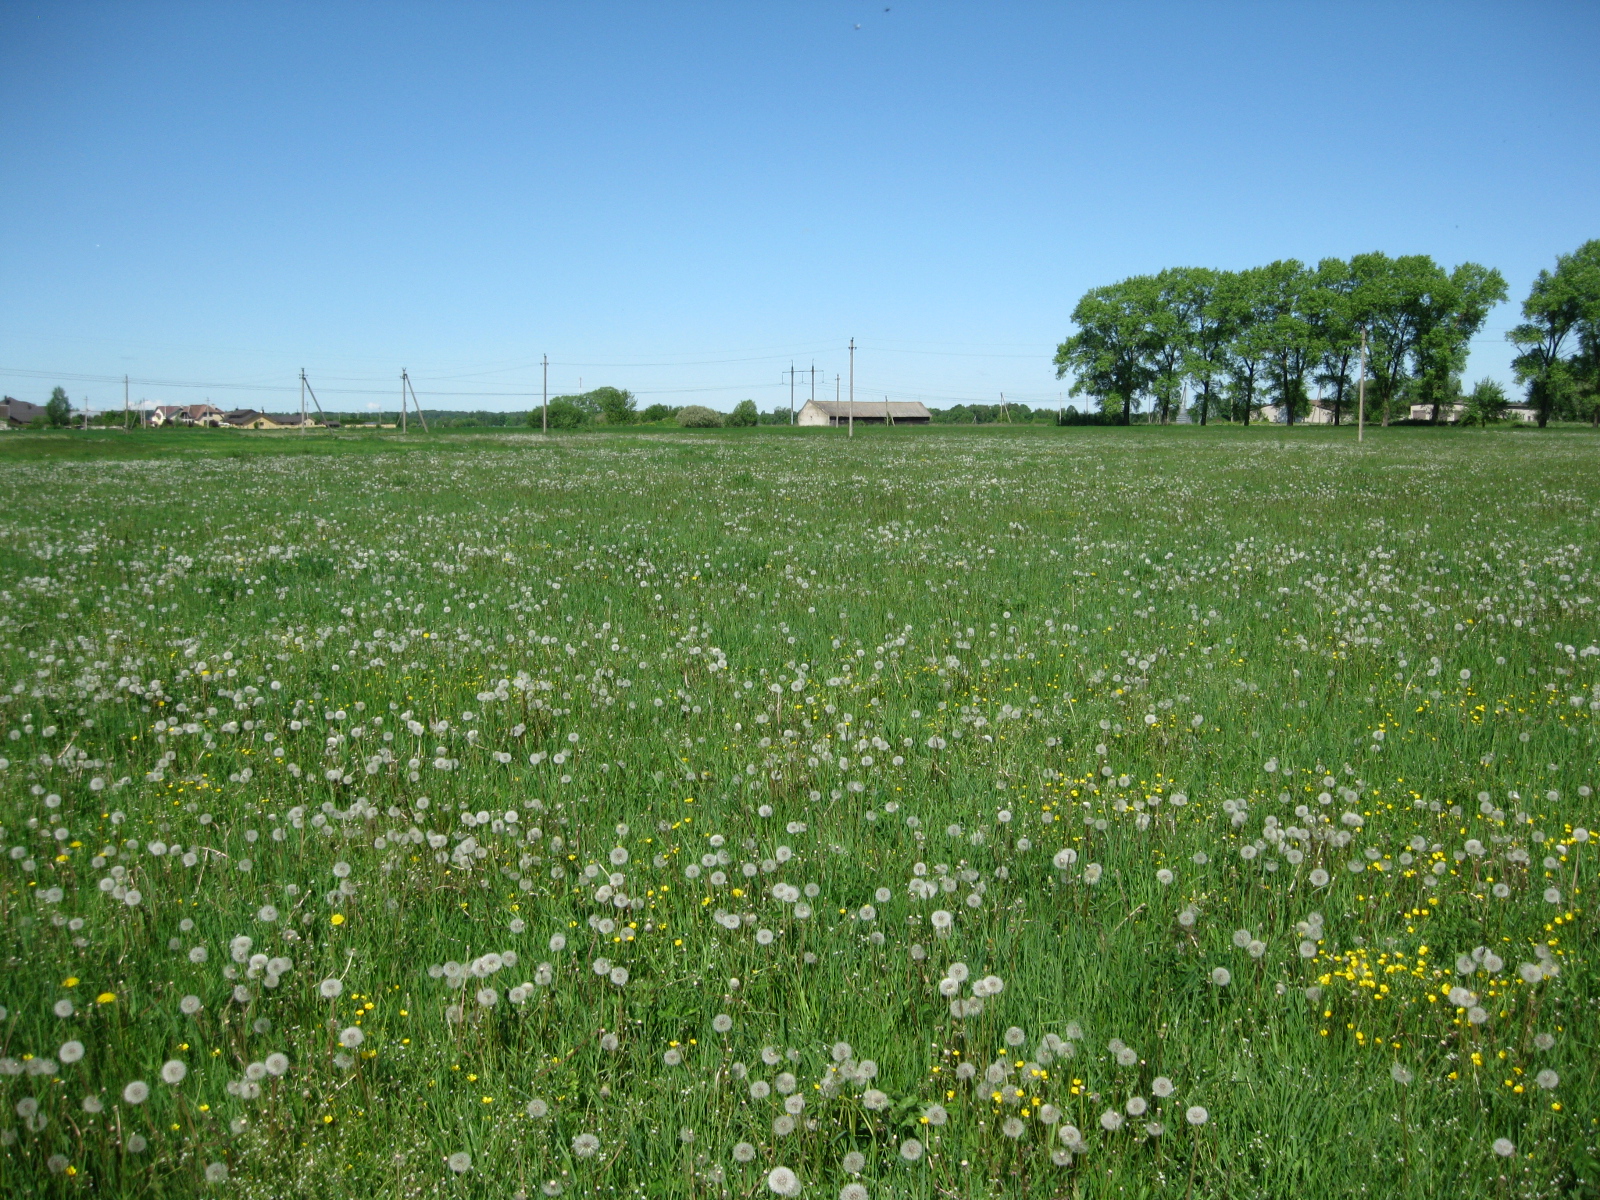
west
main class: Grassland
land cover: Grassland without tree/shrub cover
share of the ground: > 75 %
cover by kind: herbaceous plants 100 %
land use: Agriculture (excluding fallow land and kitchen gardens)
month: May
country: LT
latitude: 55.7833
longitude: 24.3020
